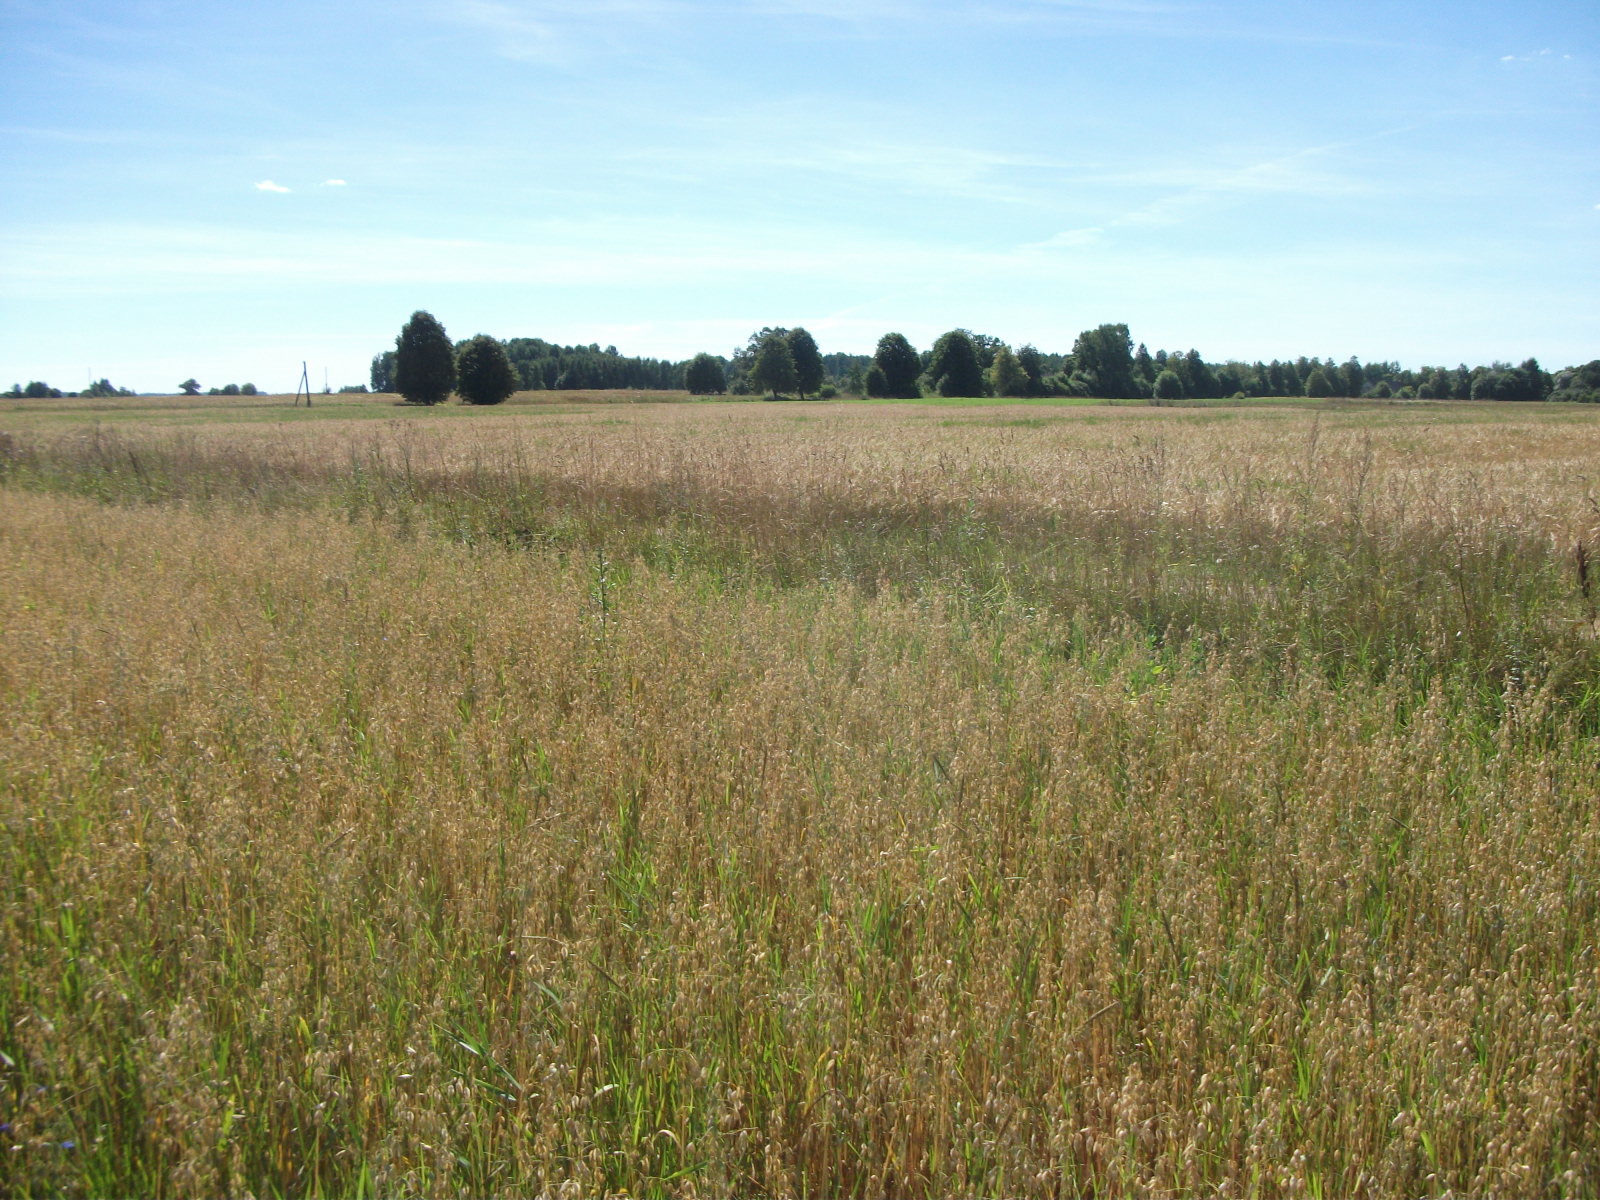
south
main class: Cropland
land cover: Oats
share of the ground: > 75 %
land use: Agriculture (excluding fallow land and kitchen gardens)
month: August
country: LV
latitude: 56.6673
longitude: 26.1104
